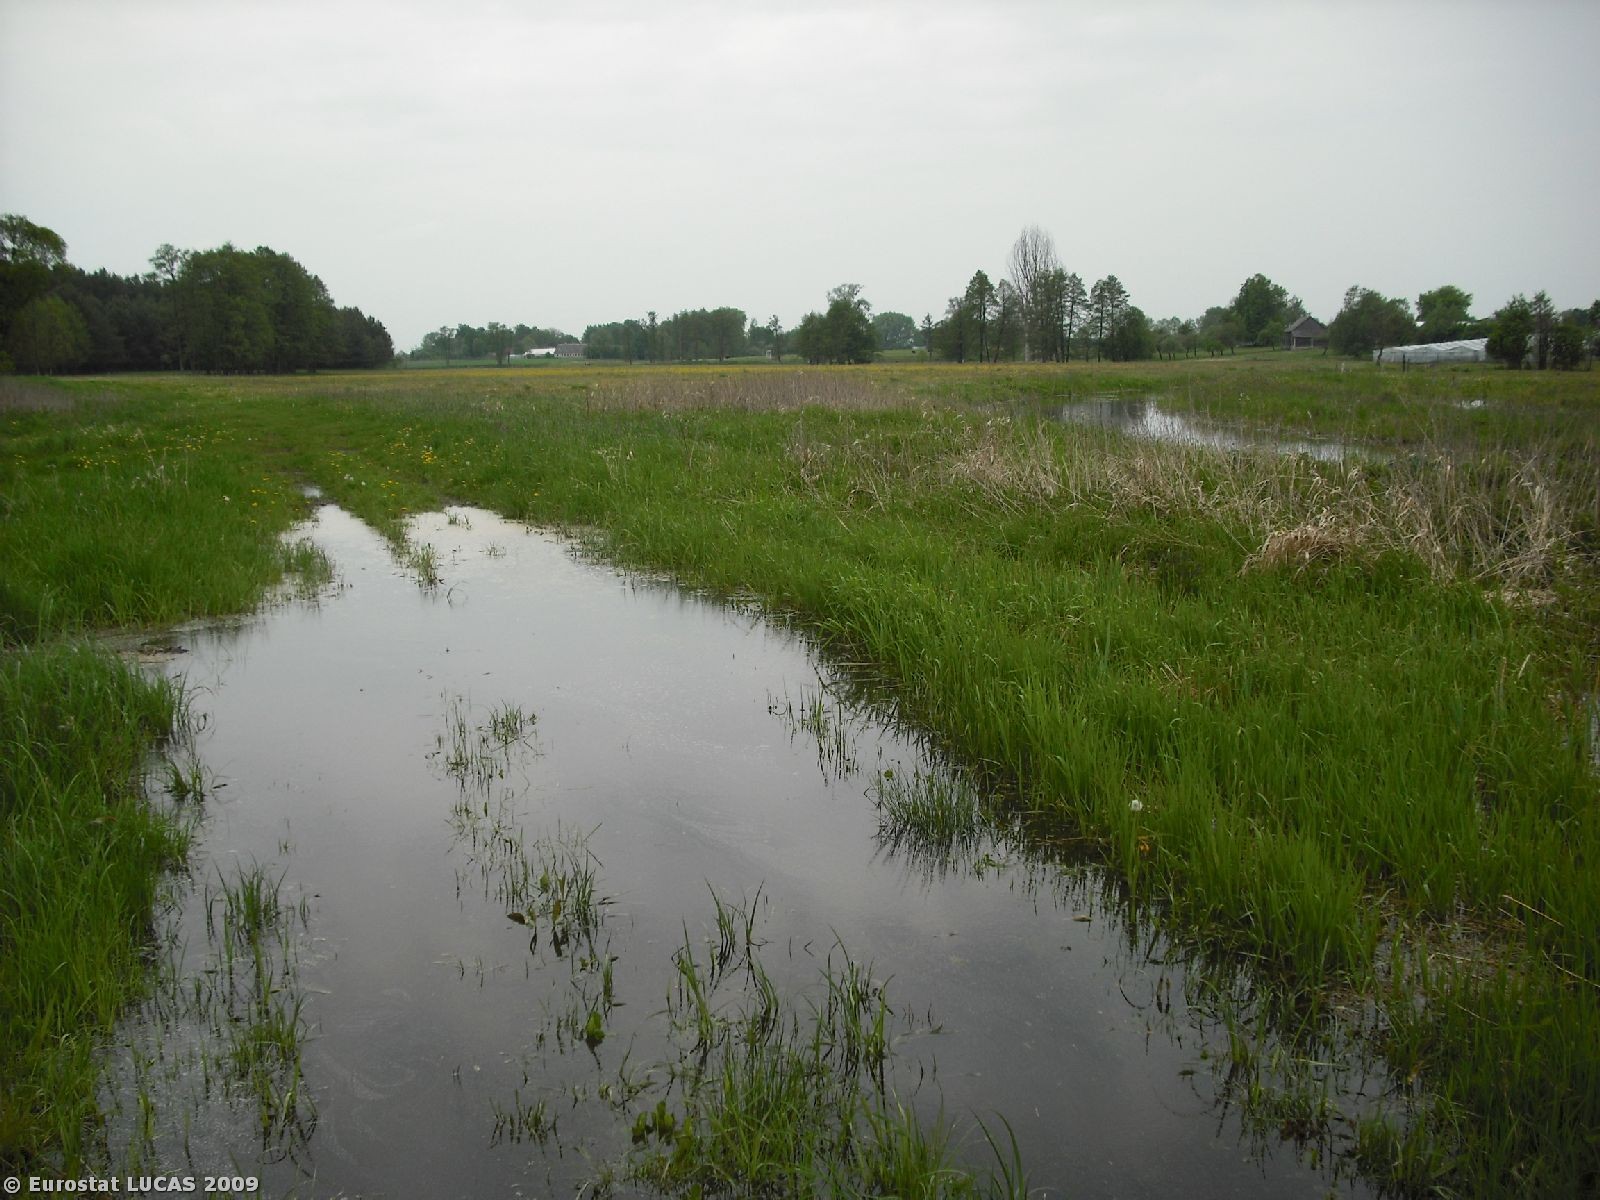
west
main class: Grassland
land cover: Grassland without tree/shrub cover
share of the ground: > 75 %
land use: Agriculture (excluding fallow land and kitchen gardens)
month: May
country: PL
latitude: 52.8165
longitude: 23.2403
